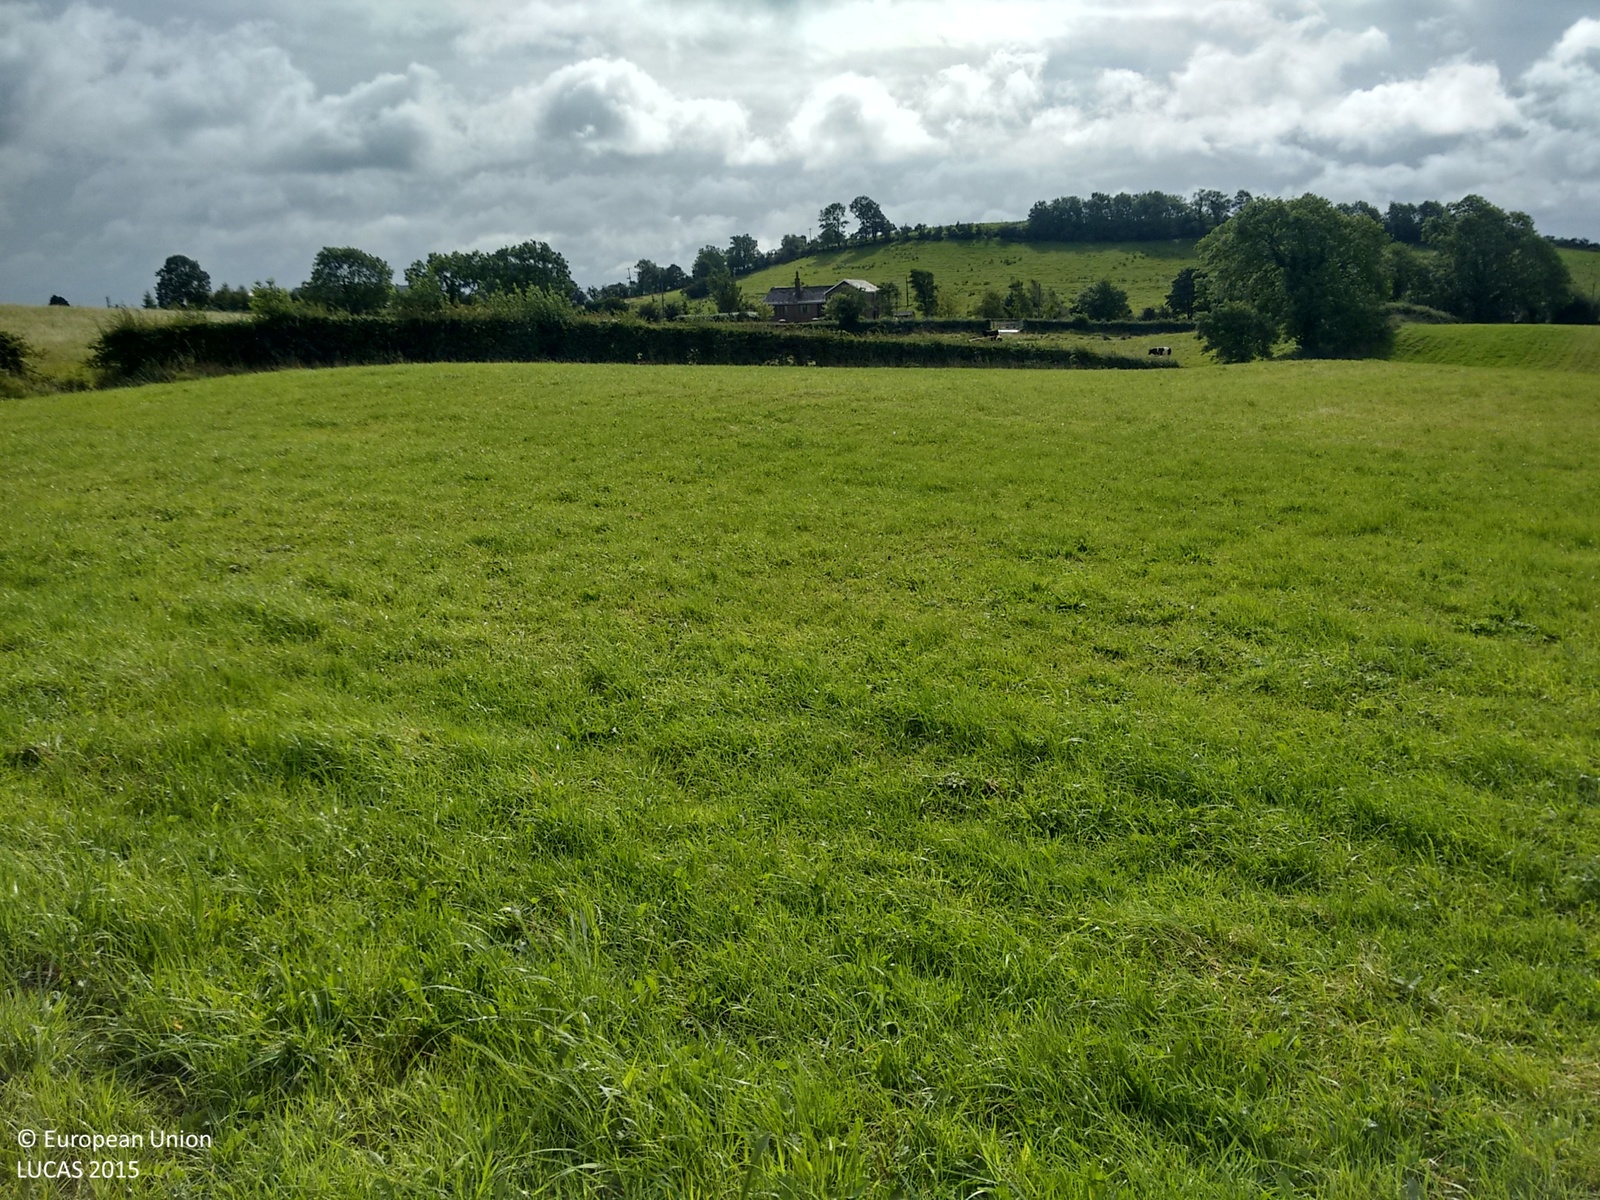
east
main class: Grassland
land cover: Grassland without tree/shrub cover
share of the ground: > 75 %
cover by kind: herbaceous plants 100 %
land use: Agriculture (excluding fallow land and kitchen gardens)
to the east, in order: Grassland without tree/shrub cover; Abandoned hedges; Fences; Grassland without tree/shrub cover; Abandoned hedges; Fences; Grassland without tree/shrub cover; Abandoned hedges; Fences; Grass margins; Paved roads, cycling and walking lanes; Grass margins; Electric lines; Managed hedges; Grassland without tree/shrub cover
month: August
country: GB
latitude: 54.4715
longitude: -5.8926
